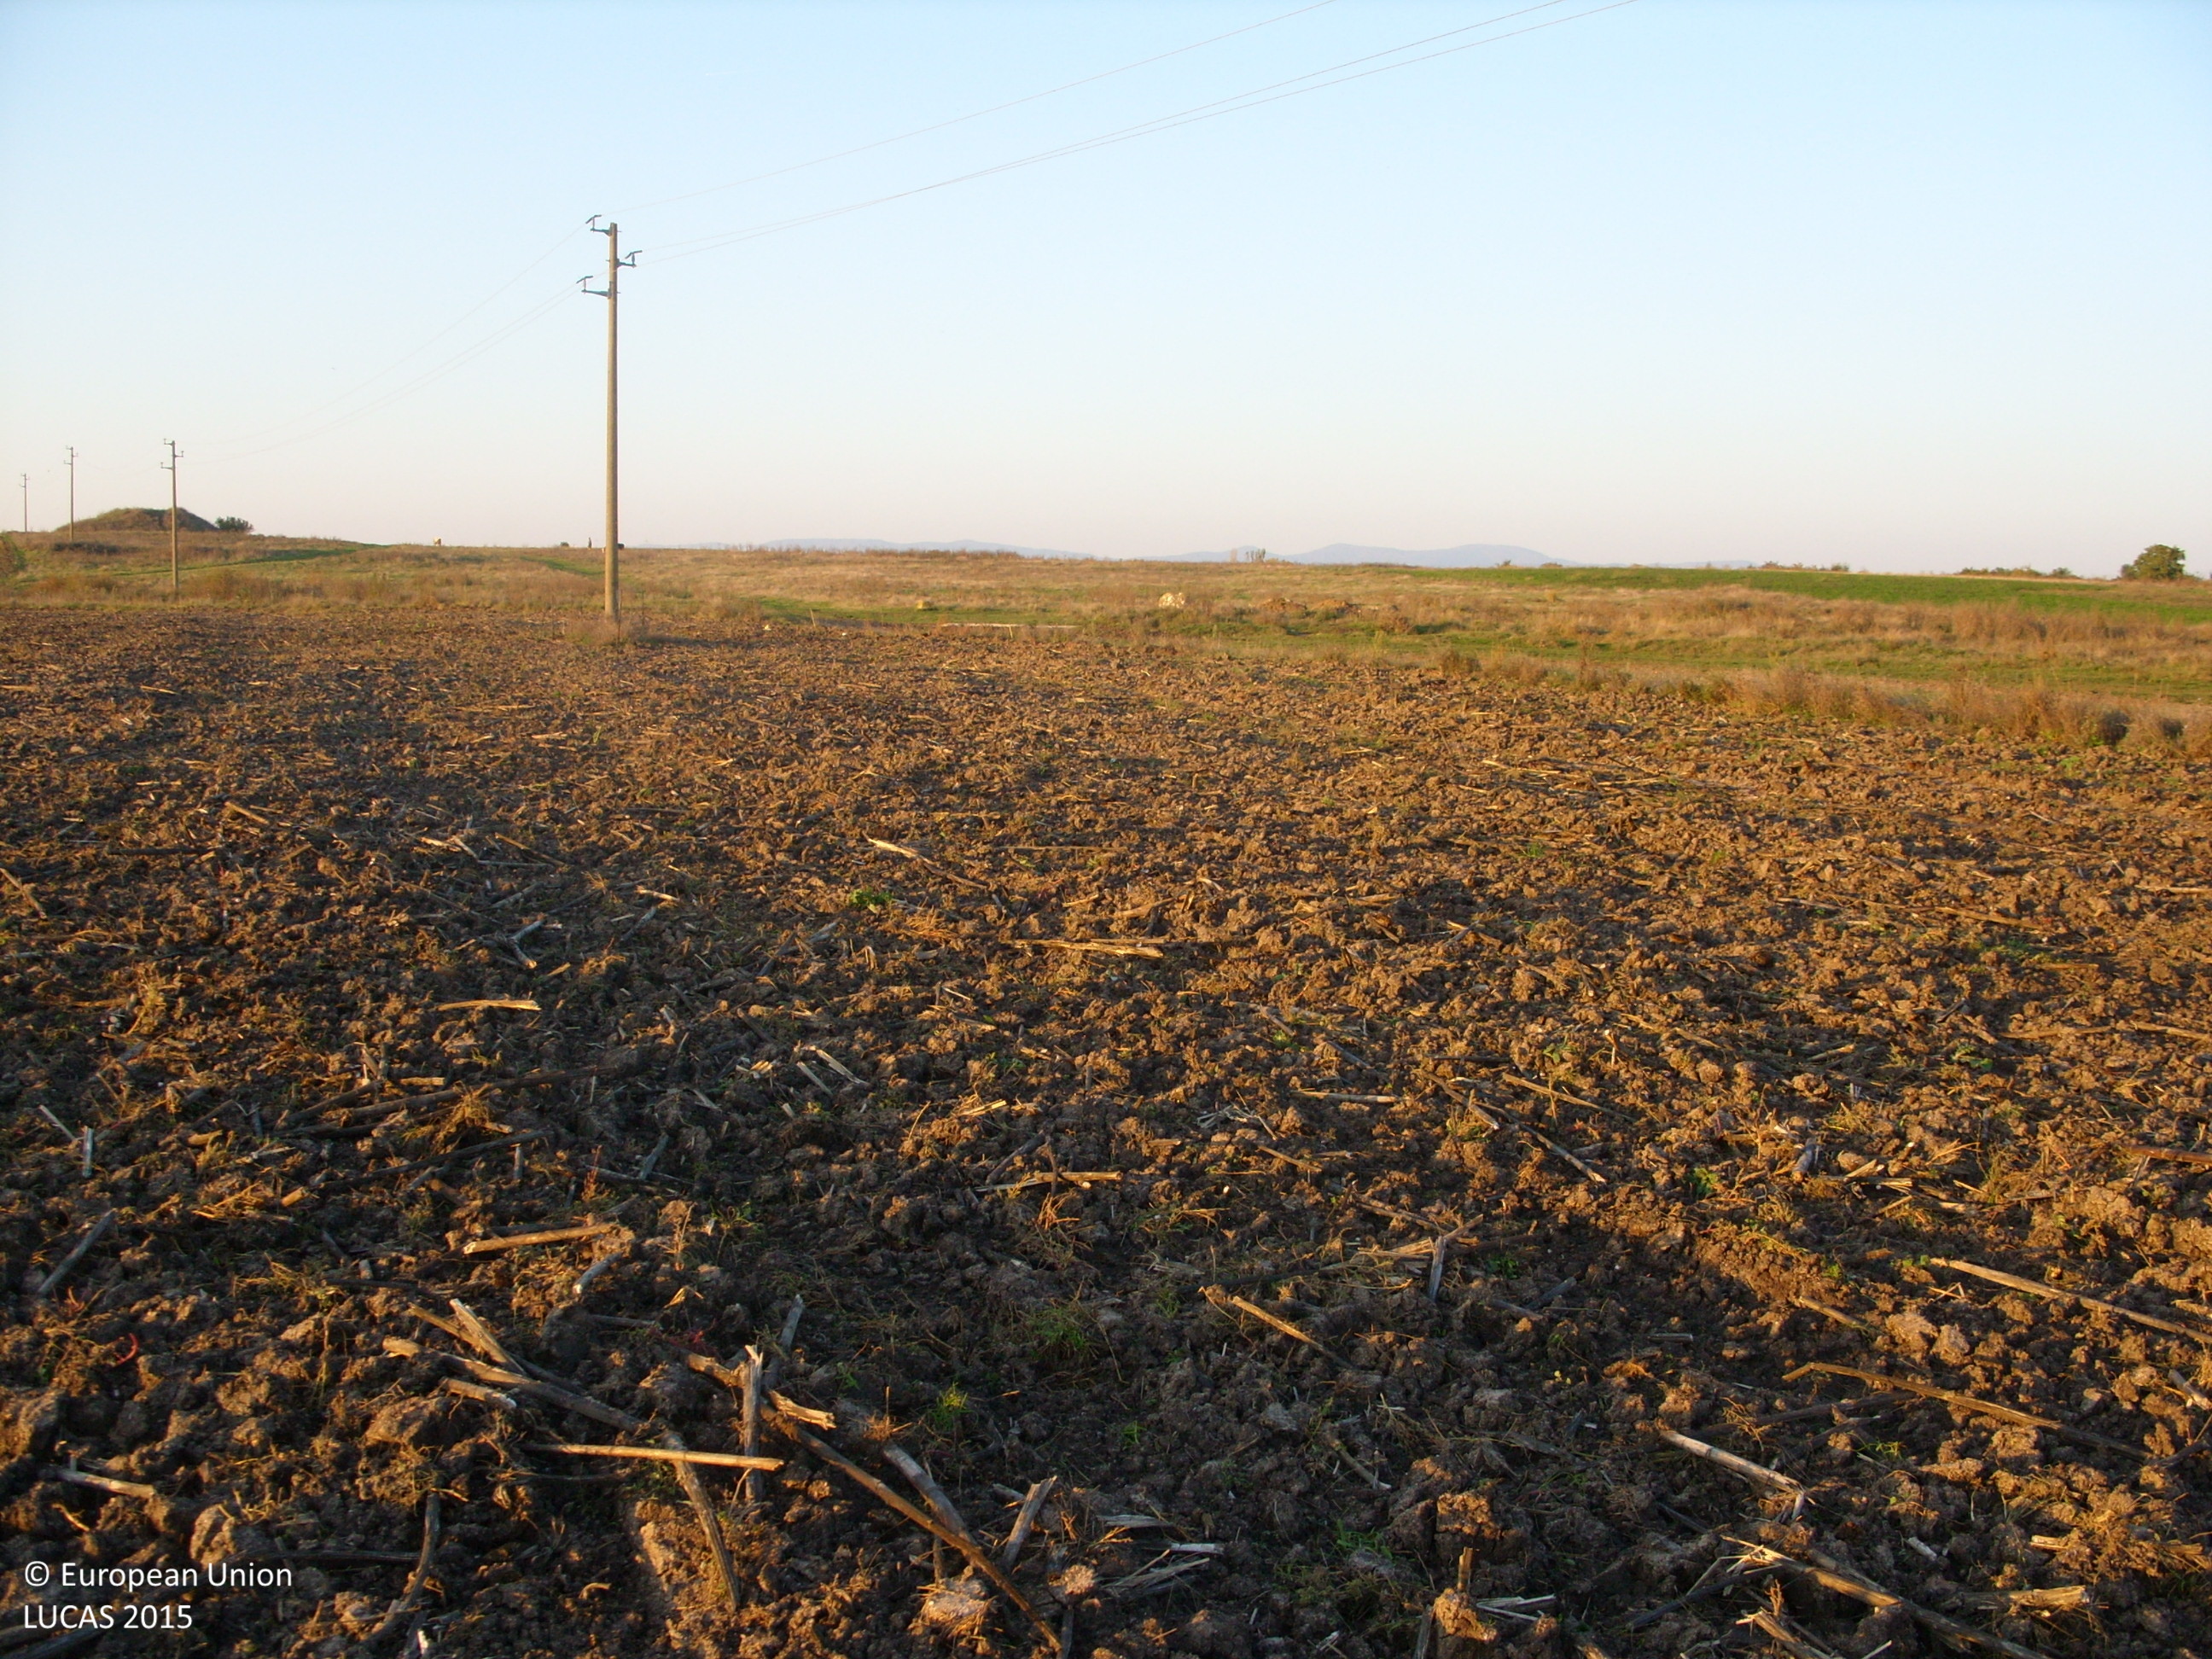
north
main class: Cropland
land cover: Sunflower
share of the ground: < 10 %
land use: Agriculture (excluding fallow land and kitchen gardens)
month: October
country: BG
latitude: 42.3046
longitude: 25.0897
